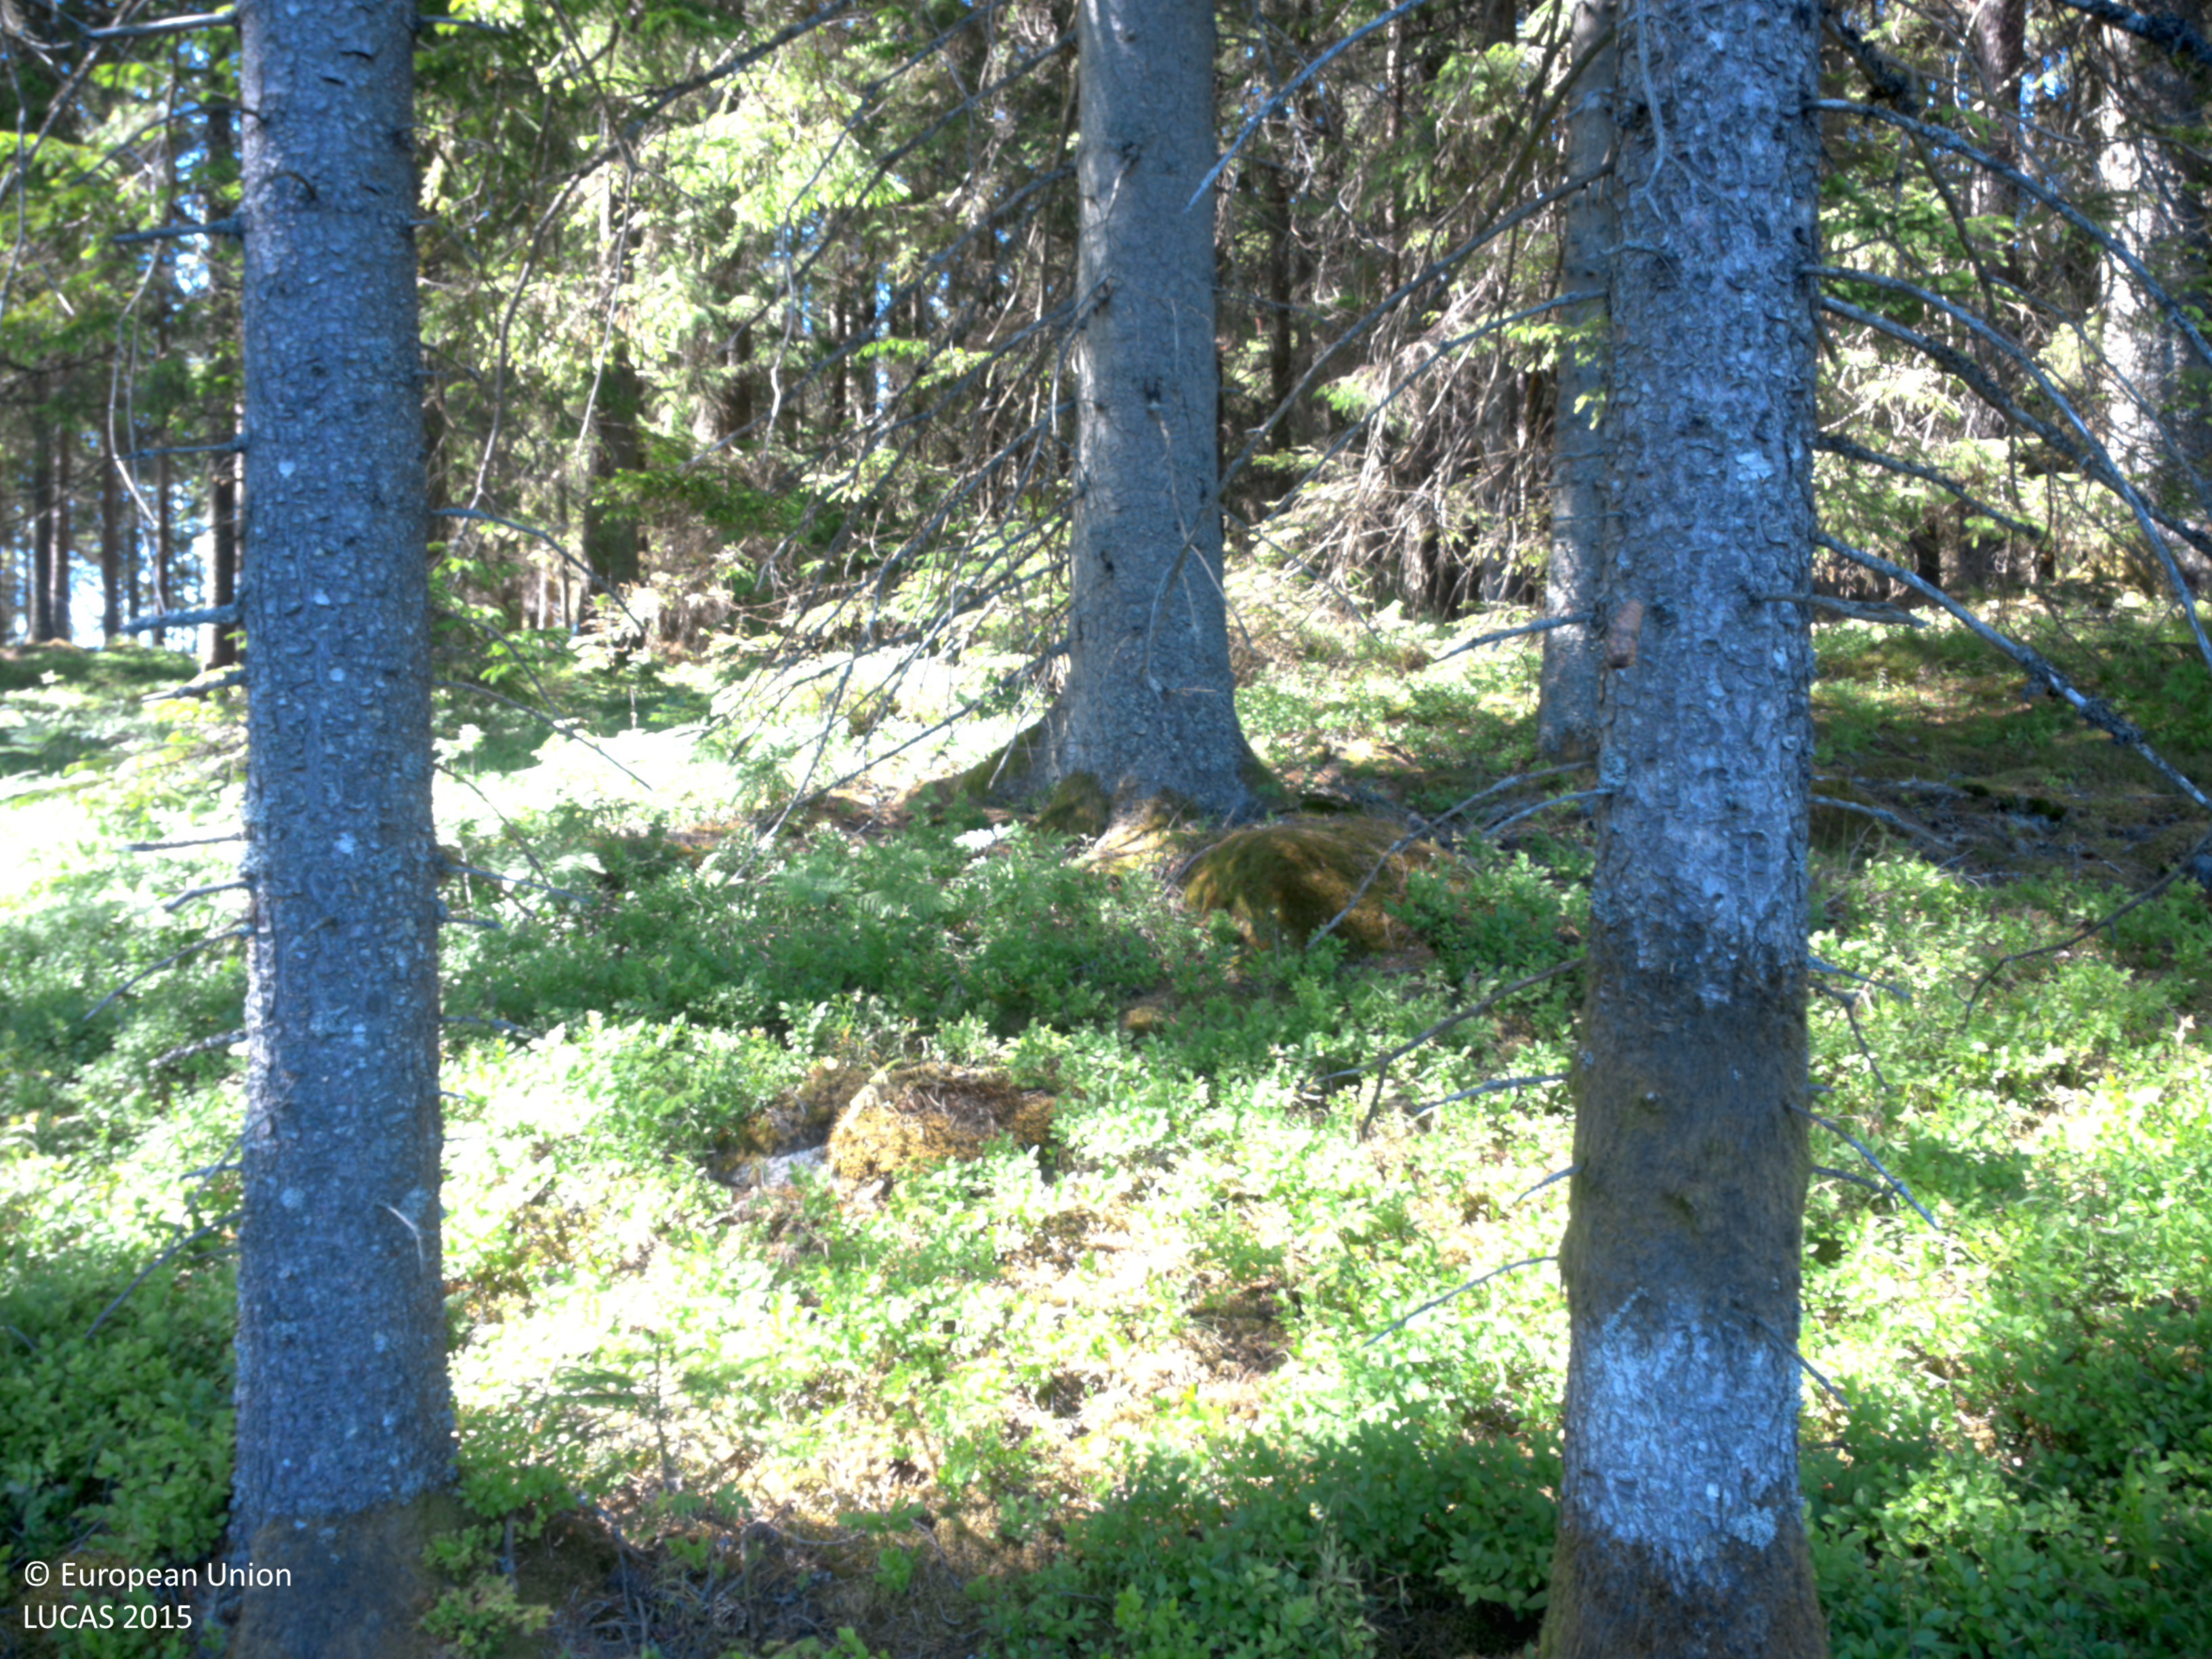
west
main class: Woodland
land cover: Spruce dominated coniferous woodland
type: boreal forest
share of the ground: 50 - 75 %
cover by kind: coniferous forest trees 75 %, lichens and mosses 25 %
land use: Forestry
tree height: > 5 m
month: July
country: SE
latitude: 58.7431
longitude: 12.0862
